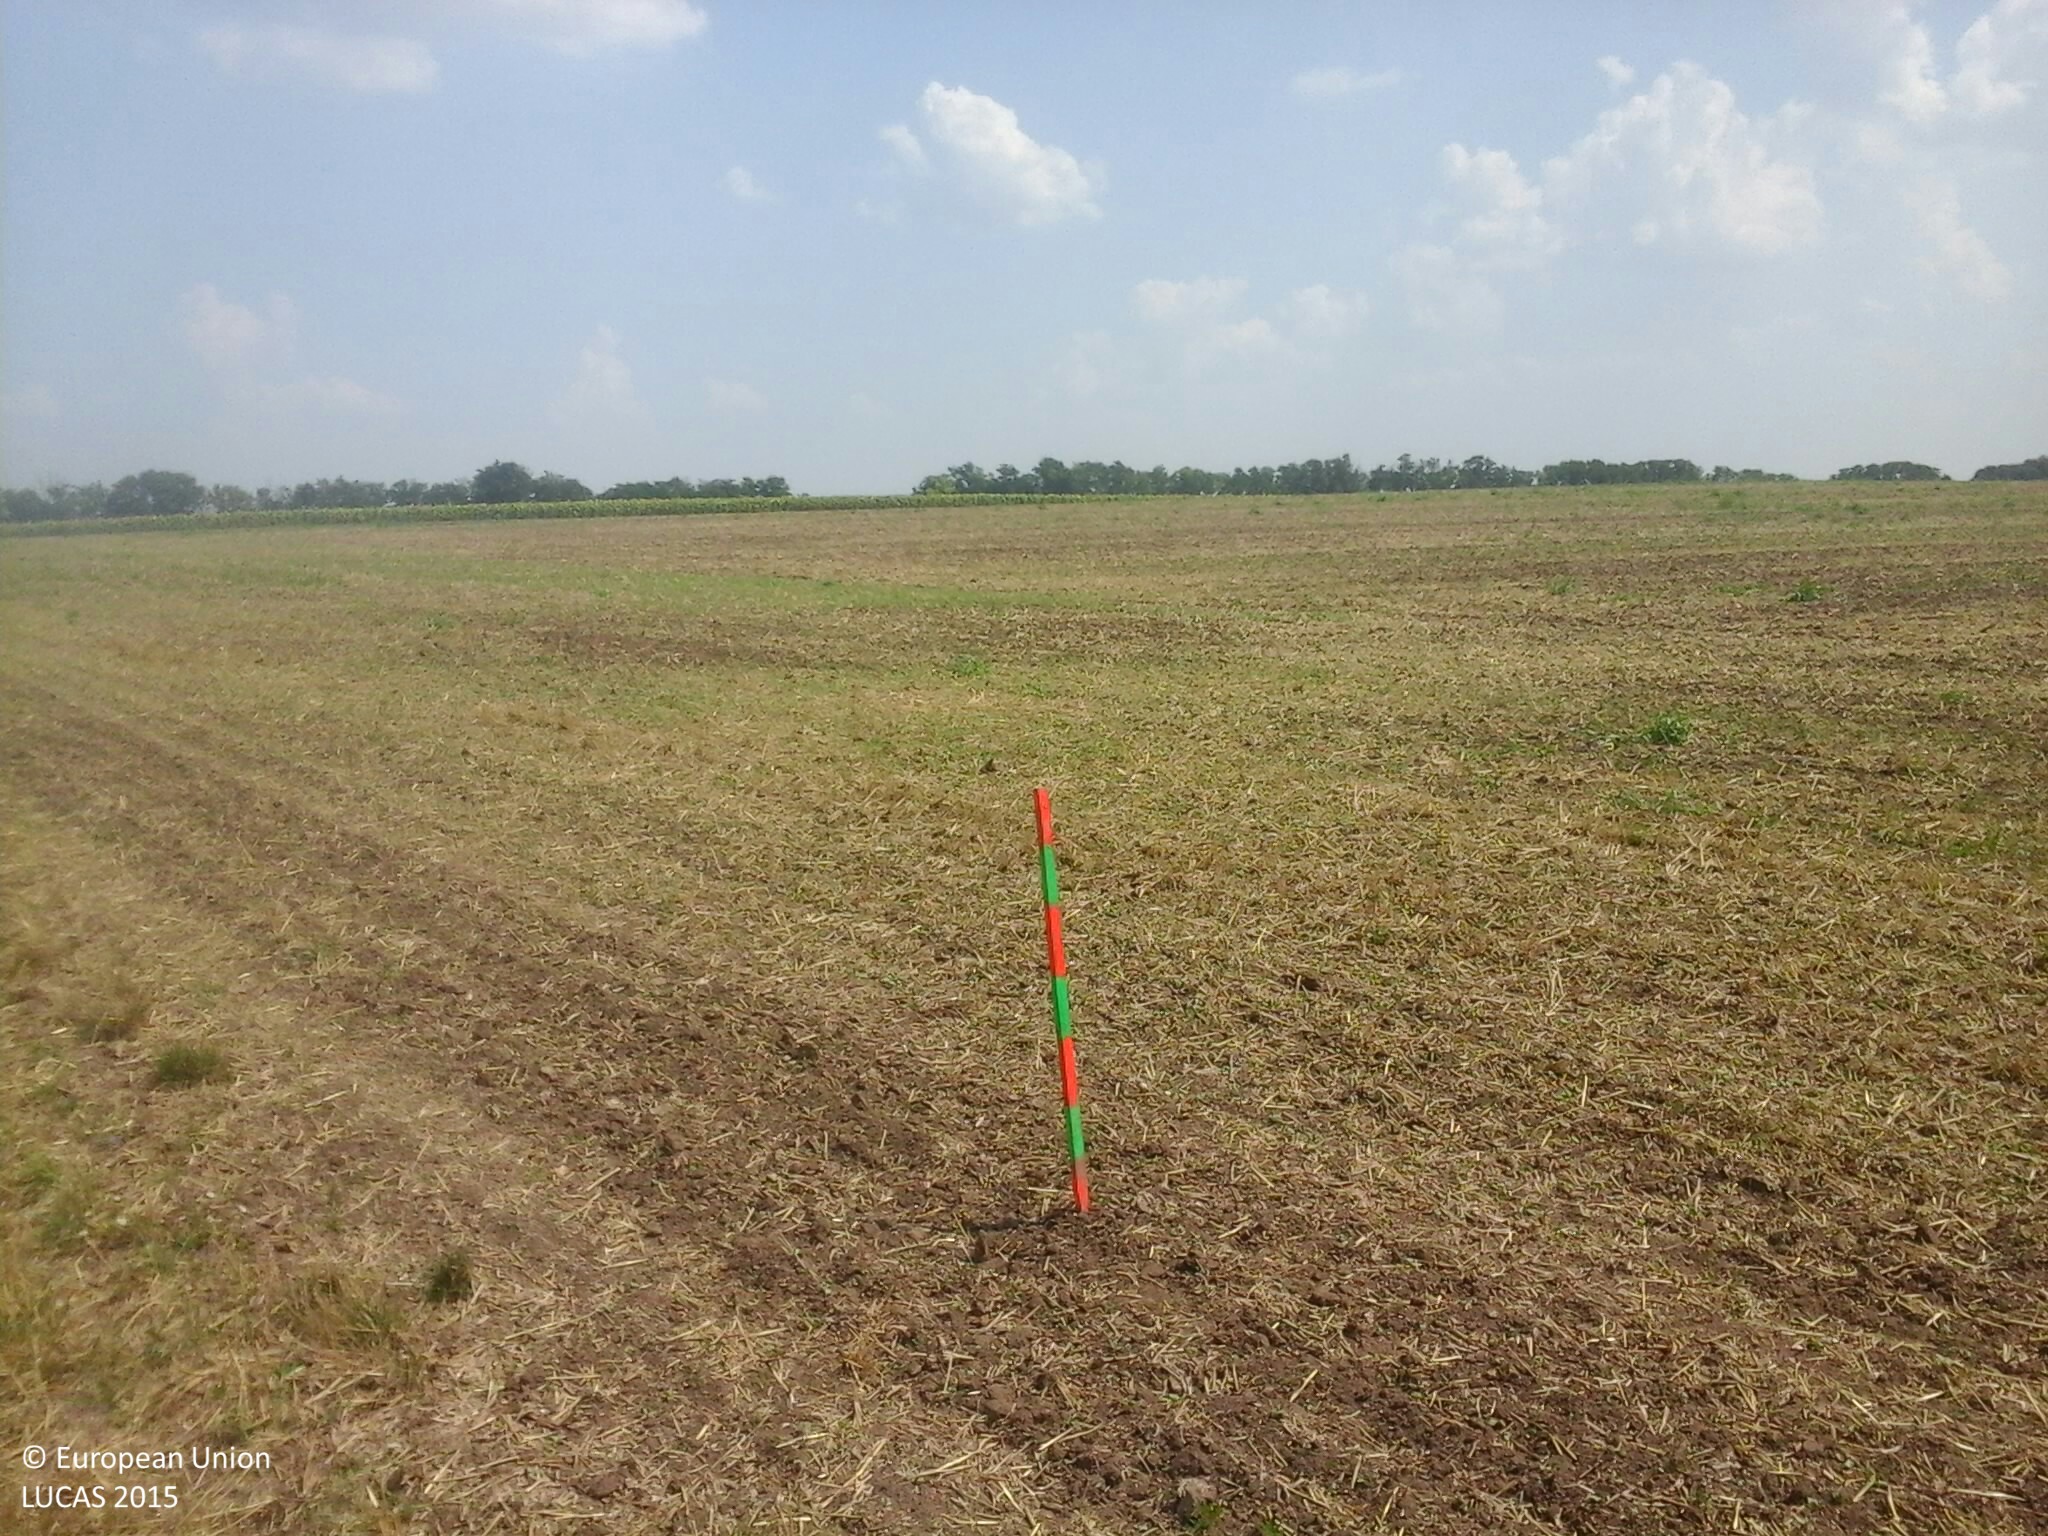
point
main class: Cropland
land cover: Common wheat
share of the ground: < 10 %
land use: Agriculture (excluding fallow land and kitchen gardens)
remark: Harvested field
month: August
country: HU
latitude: 46.8797
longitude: 18.2902
